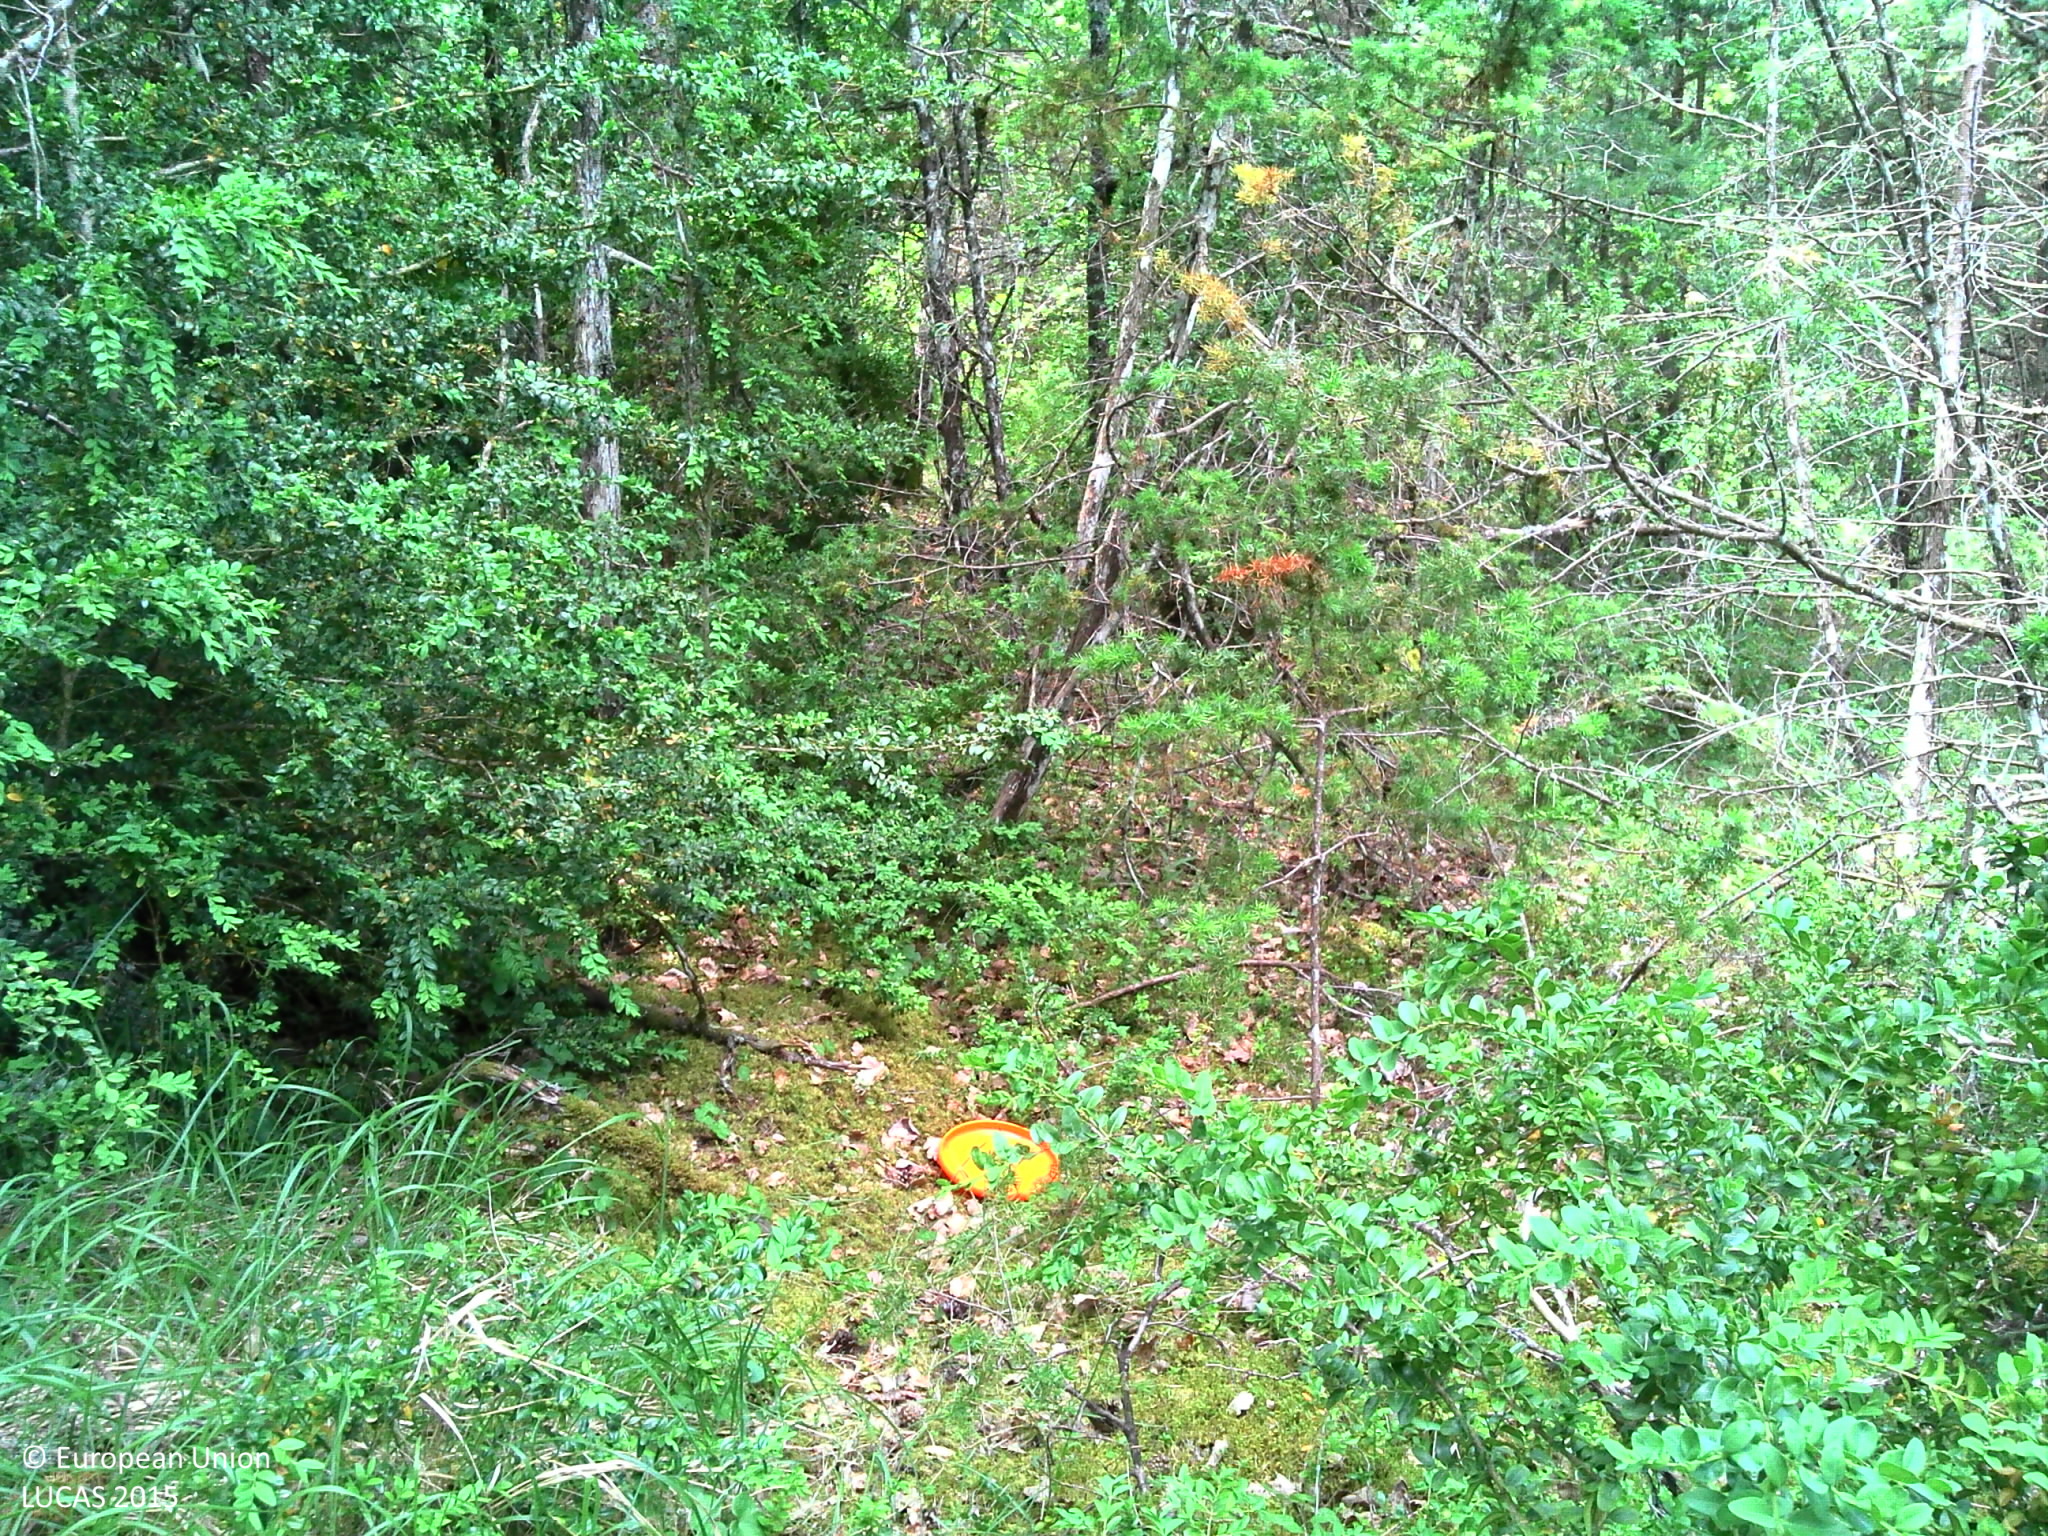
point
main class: Woodland
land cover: Pine dominated mixed woodland
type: mountainous beech forest
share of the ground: > 75 %
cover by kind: coniferous forest trees 35 %, broadleaved forest trees 35 %, herbaceous plants 20 %, lichens and mosses 10 %
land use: Forestry
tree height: > 5 m
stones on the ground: 25 - 50 %
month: June
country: FR
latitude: 44.1483
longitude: 3.2425
